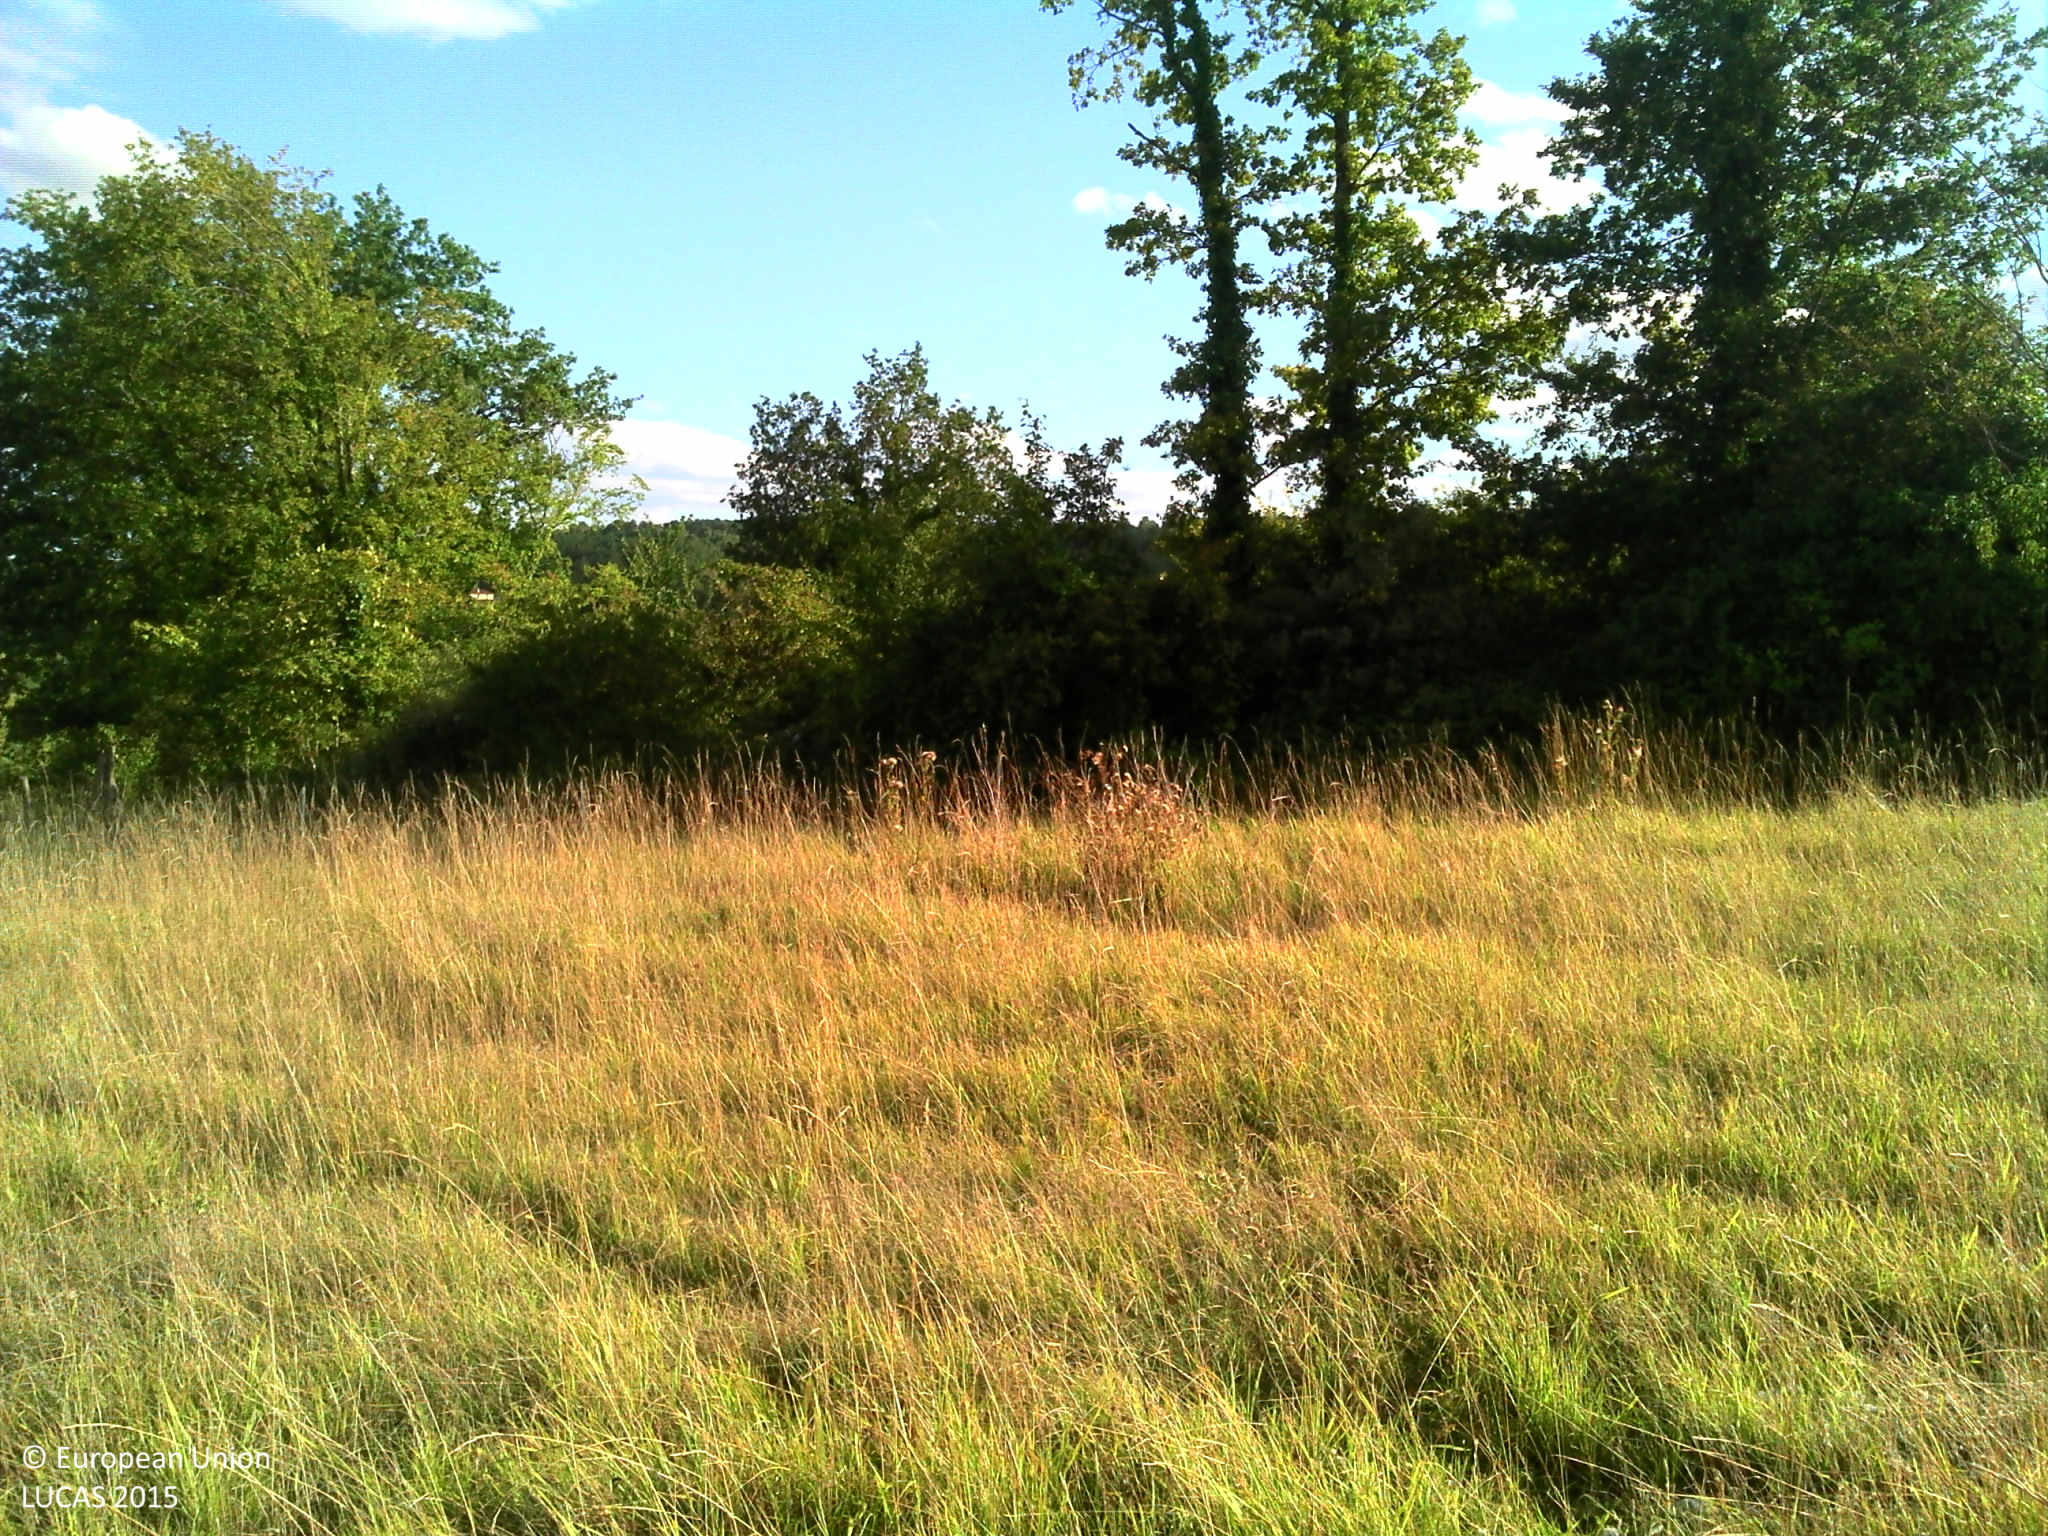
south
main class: Grassland
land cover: Grassland without tree/shrub cover
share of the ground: > 75 %
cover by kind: herbaceous plants 90 %, lichens and mosses 10 %
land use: Agriculture (excluding fallow land and kitchen gardens)
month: August
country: FR
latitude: 45.1869
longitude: 0.5324
